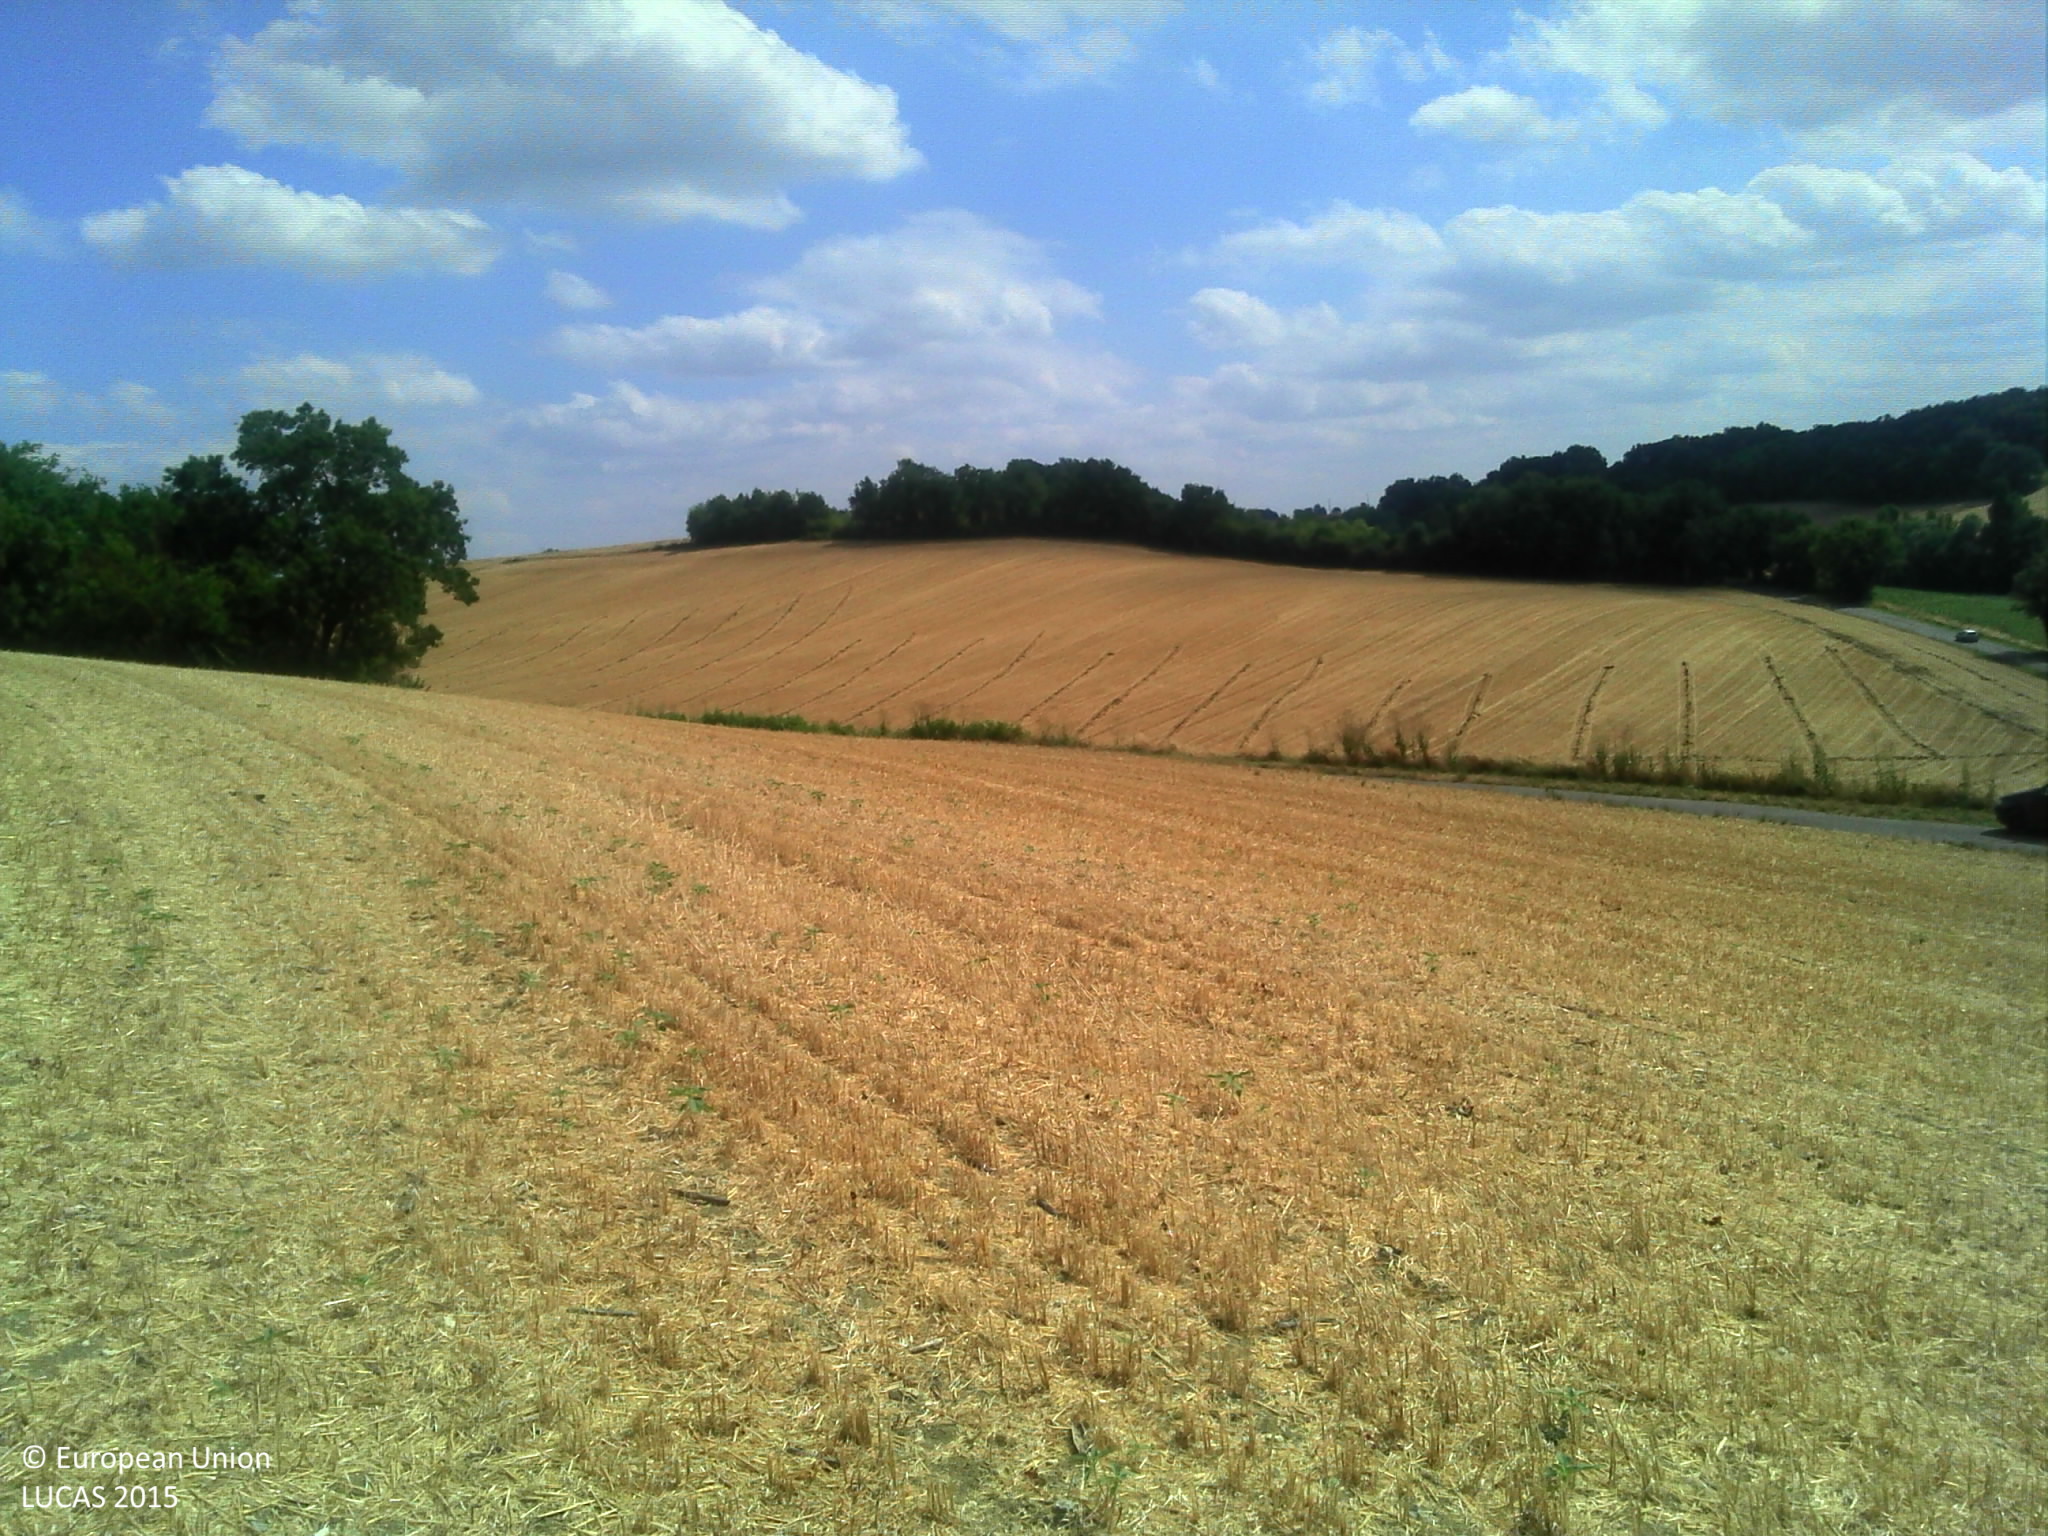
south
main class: Cropland
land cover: Durum wheat
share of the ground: > 75 %
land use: Agriculture (excluding fallow land and kitchen gardens)
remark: Harvested field
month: July
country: FR
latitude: 43.9805
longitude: 0.6335
